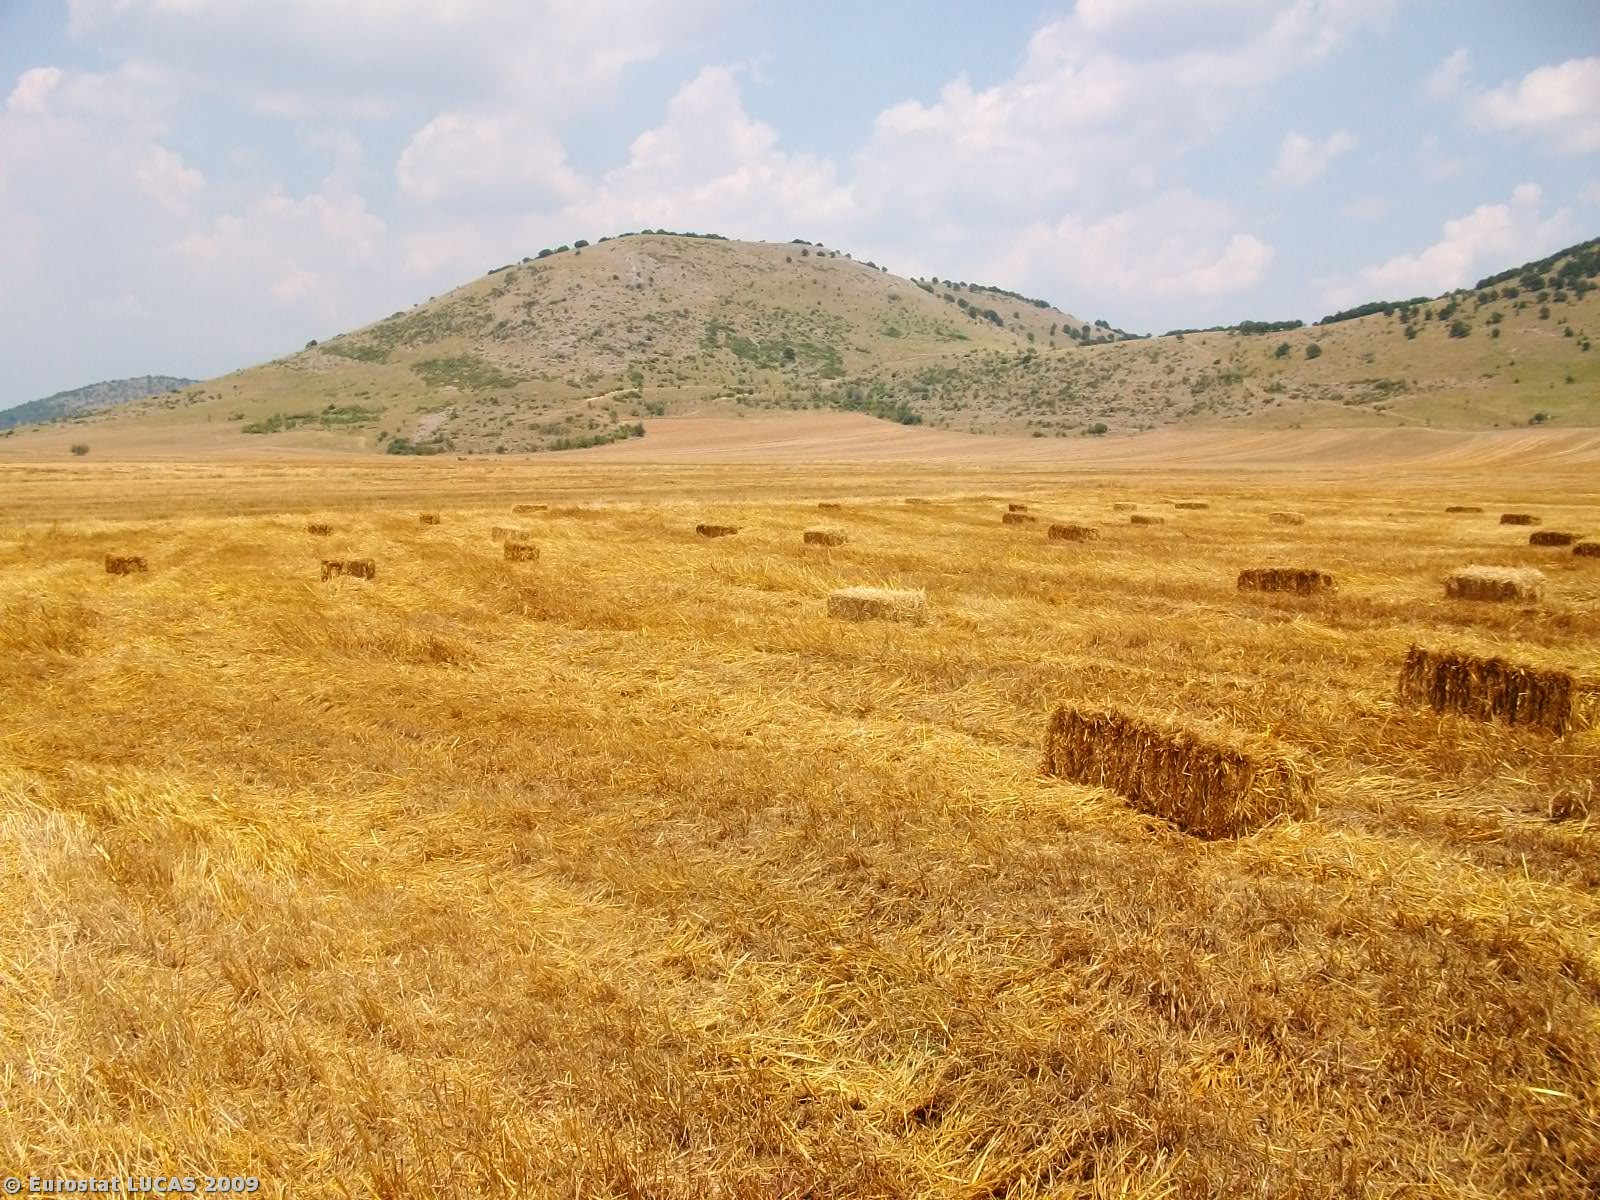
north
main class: Cropland
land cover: Durum wheat
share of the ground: < 10 %
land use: Agriculture (excluding fallow land and kitchen gardens)
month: July
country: GR
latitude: 40.6978
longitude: 21.8430
